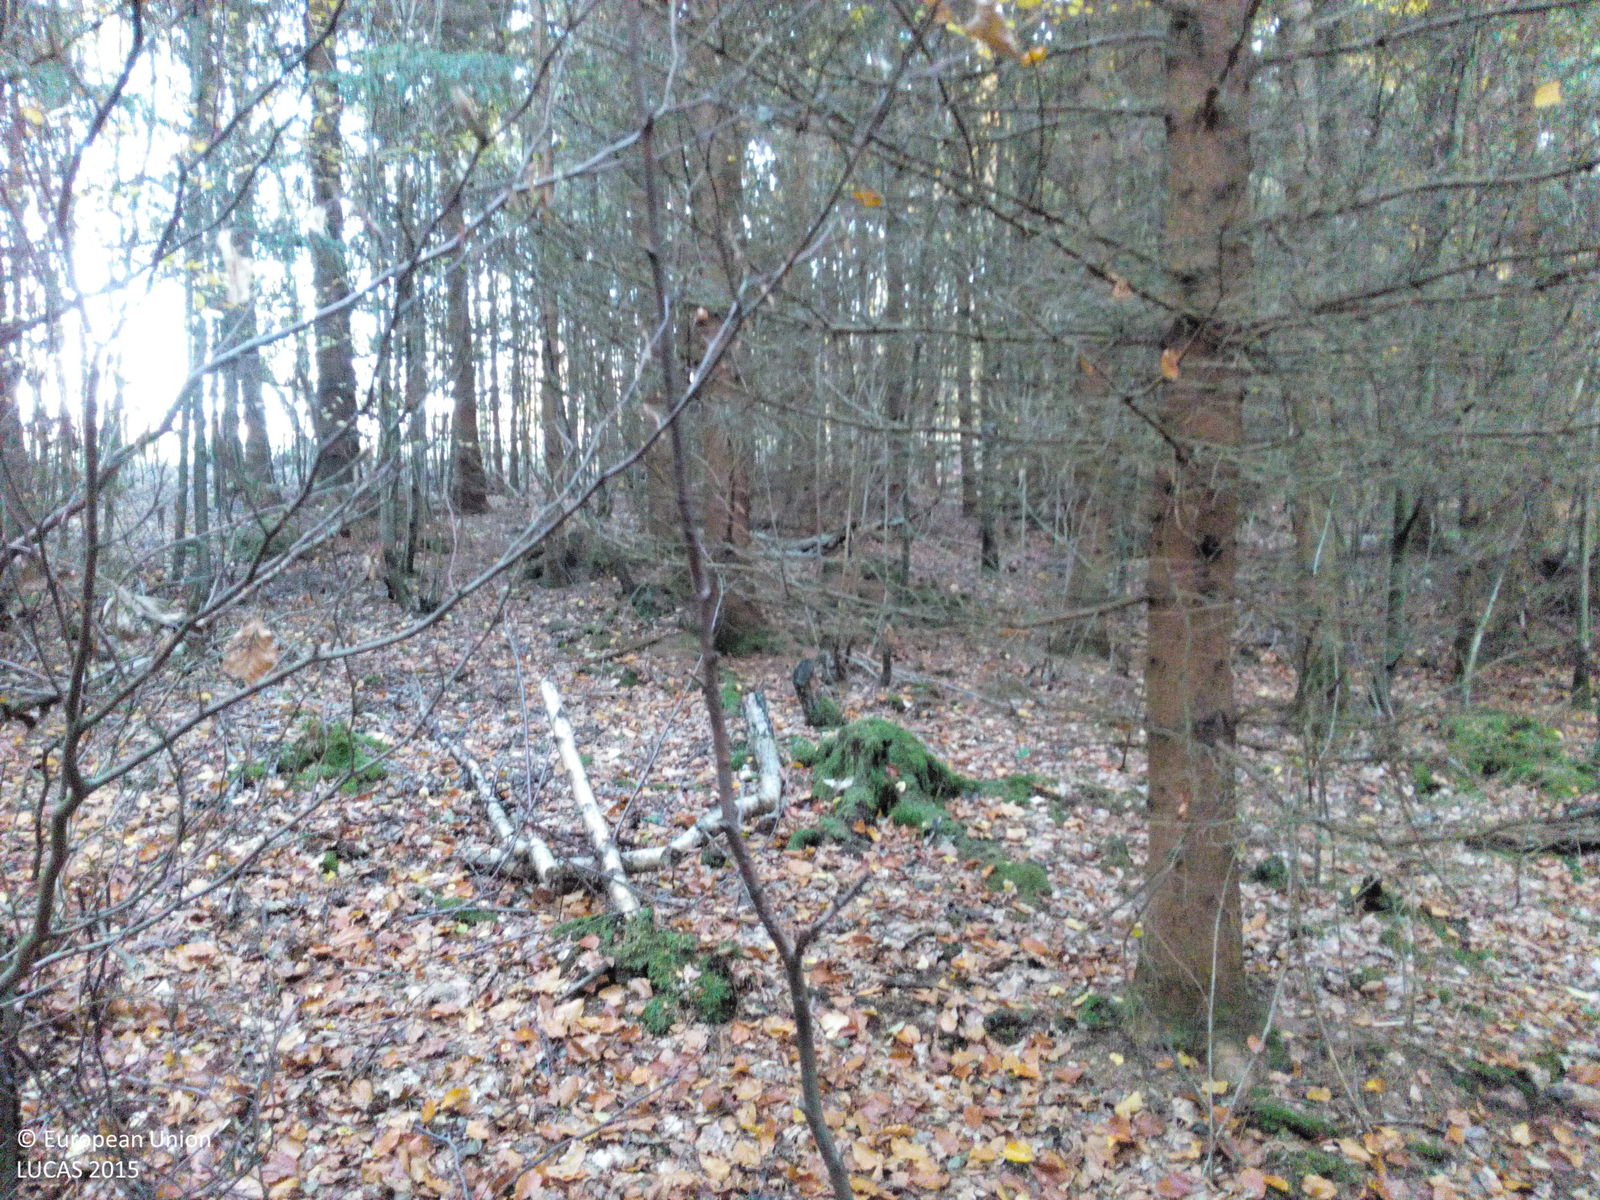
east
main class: Woodland
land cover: Spruce dominated mixed woodland
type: hemiboreal forest and nemoral coniferous forest and mixed broadleaved-coniferous forest
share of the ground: > 75 %
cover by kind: coniferous forest trees 45 %, broadleaved forest trees 30 %, lichens and mosses 15 %, unconsolidated bare surface 10 %
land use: Forestry
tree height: > 5 m
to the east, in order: Spruce dominated mixed woodland; Tracks; Fences; Grassland without tree/shrub cover; Fences; Grass margins; Tracks; Grassland without tree/shrub cover
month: October
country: DE
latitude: 50.3280
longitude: 9.9017
